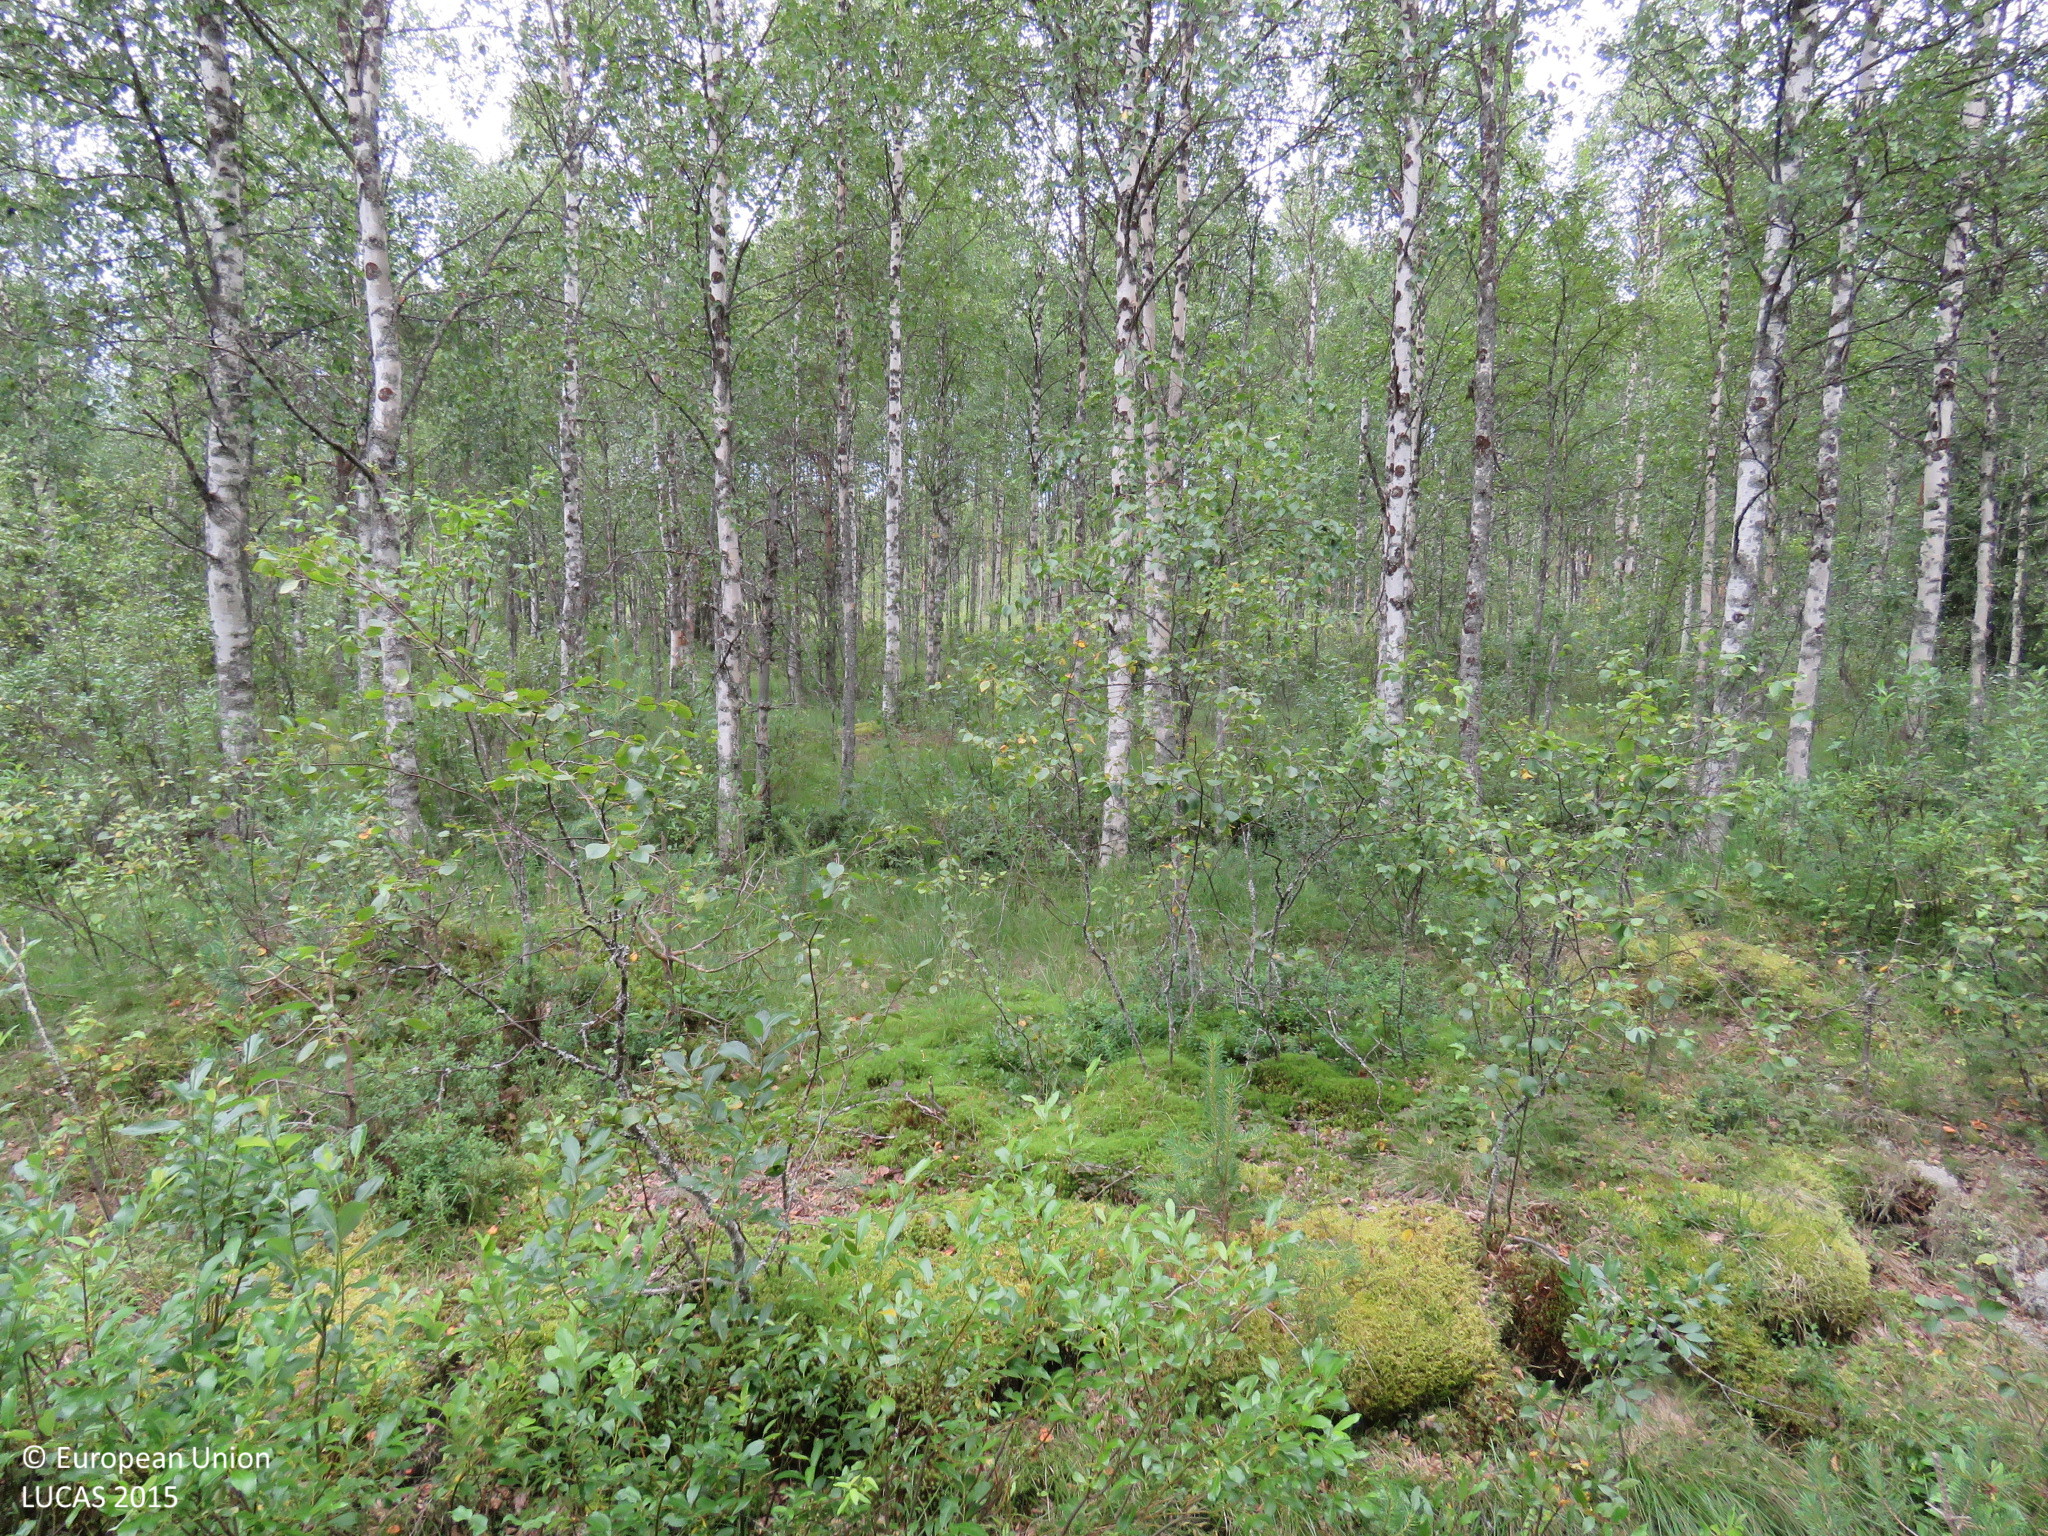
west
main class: Woodland
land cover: Broadleaved woodland
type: mire and swamp forests
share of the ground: 50 - 75 %
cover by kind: broadleaved forest trees 50 %, shrubs 20 %, herbaceous plants 20 %, coniferous forest trees 10 %
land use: Forestry
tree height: > 5 m
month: July
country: FI
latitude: 64.5954
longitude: 26.7281
